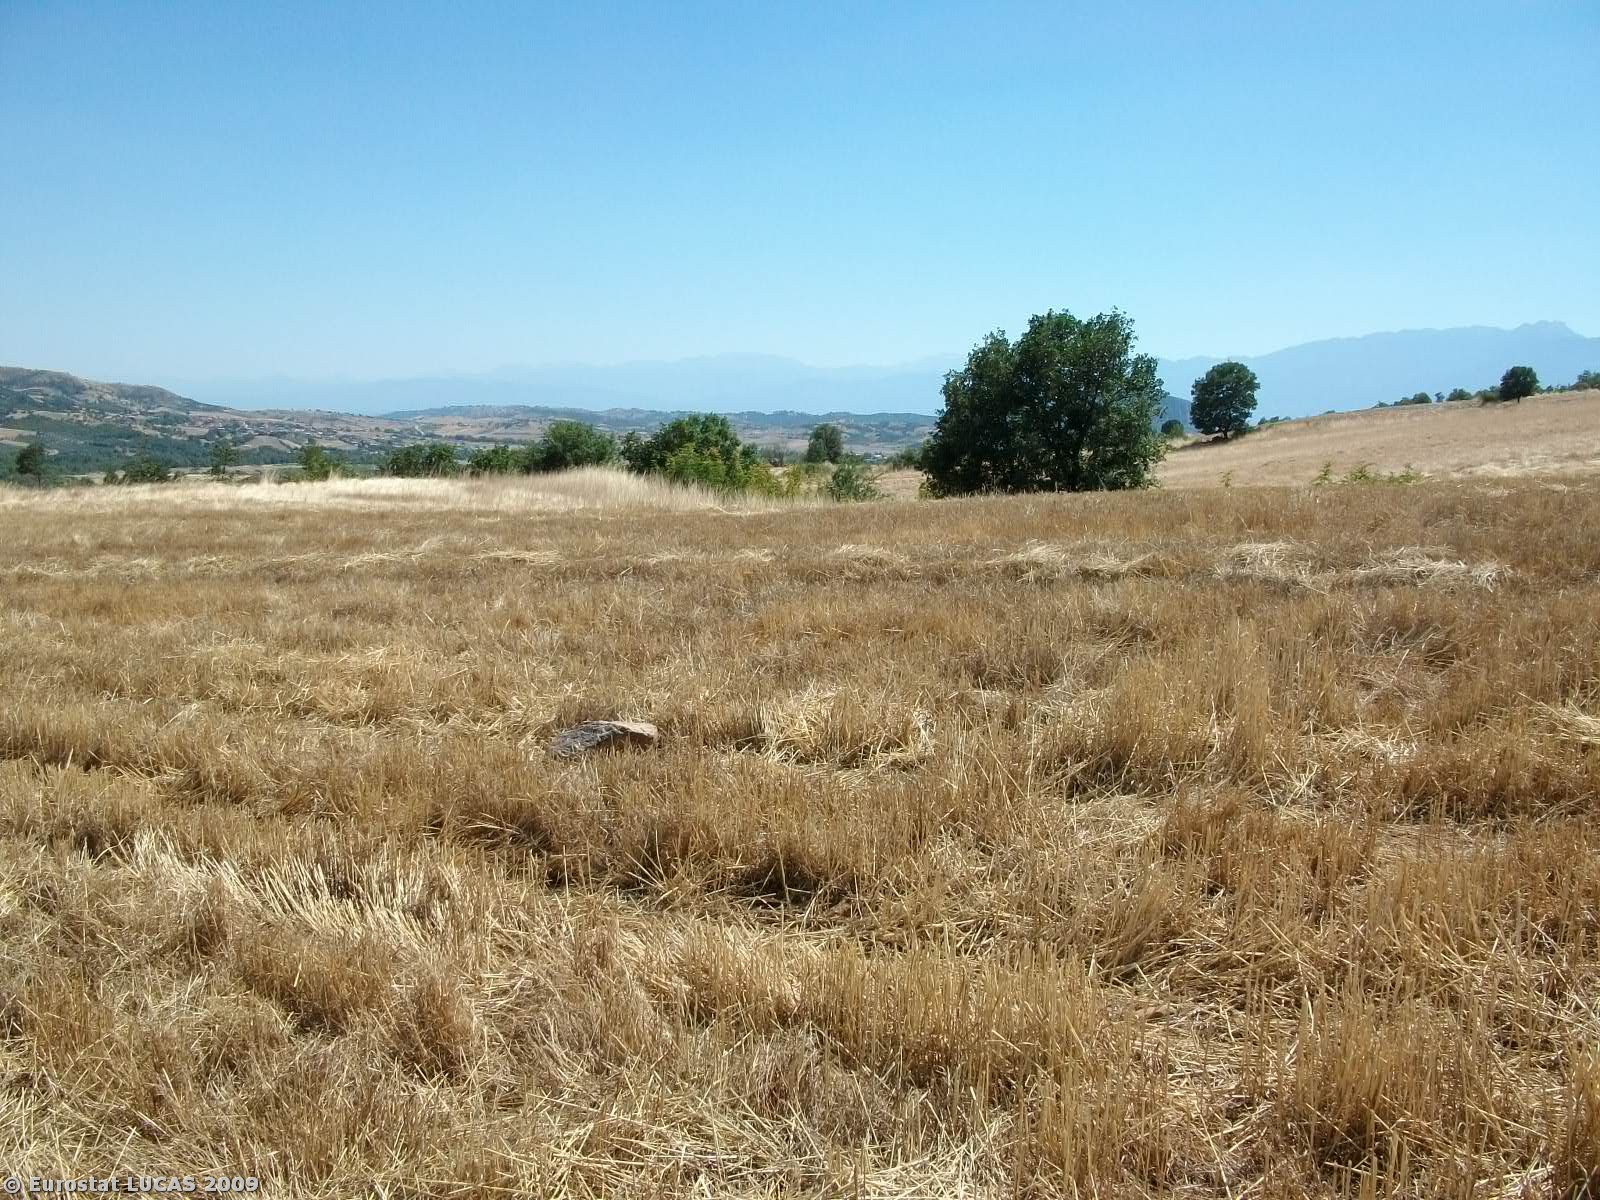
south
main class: Cropland
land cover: Durum wheat
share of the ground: < 10 %
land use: Agriculture (excluding fallow land and kitchen gardens)
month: July
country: GR
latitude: 39.7279
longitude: 21.7103
